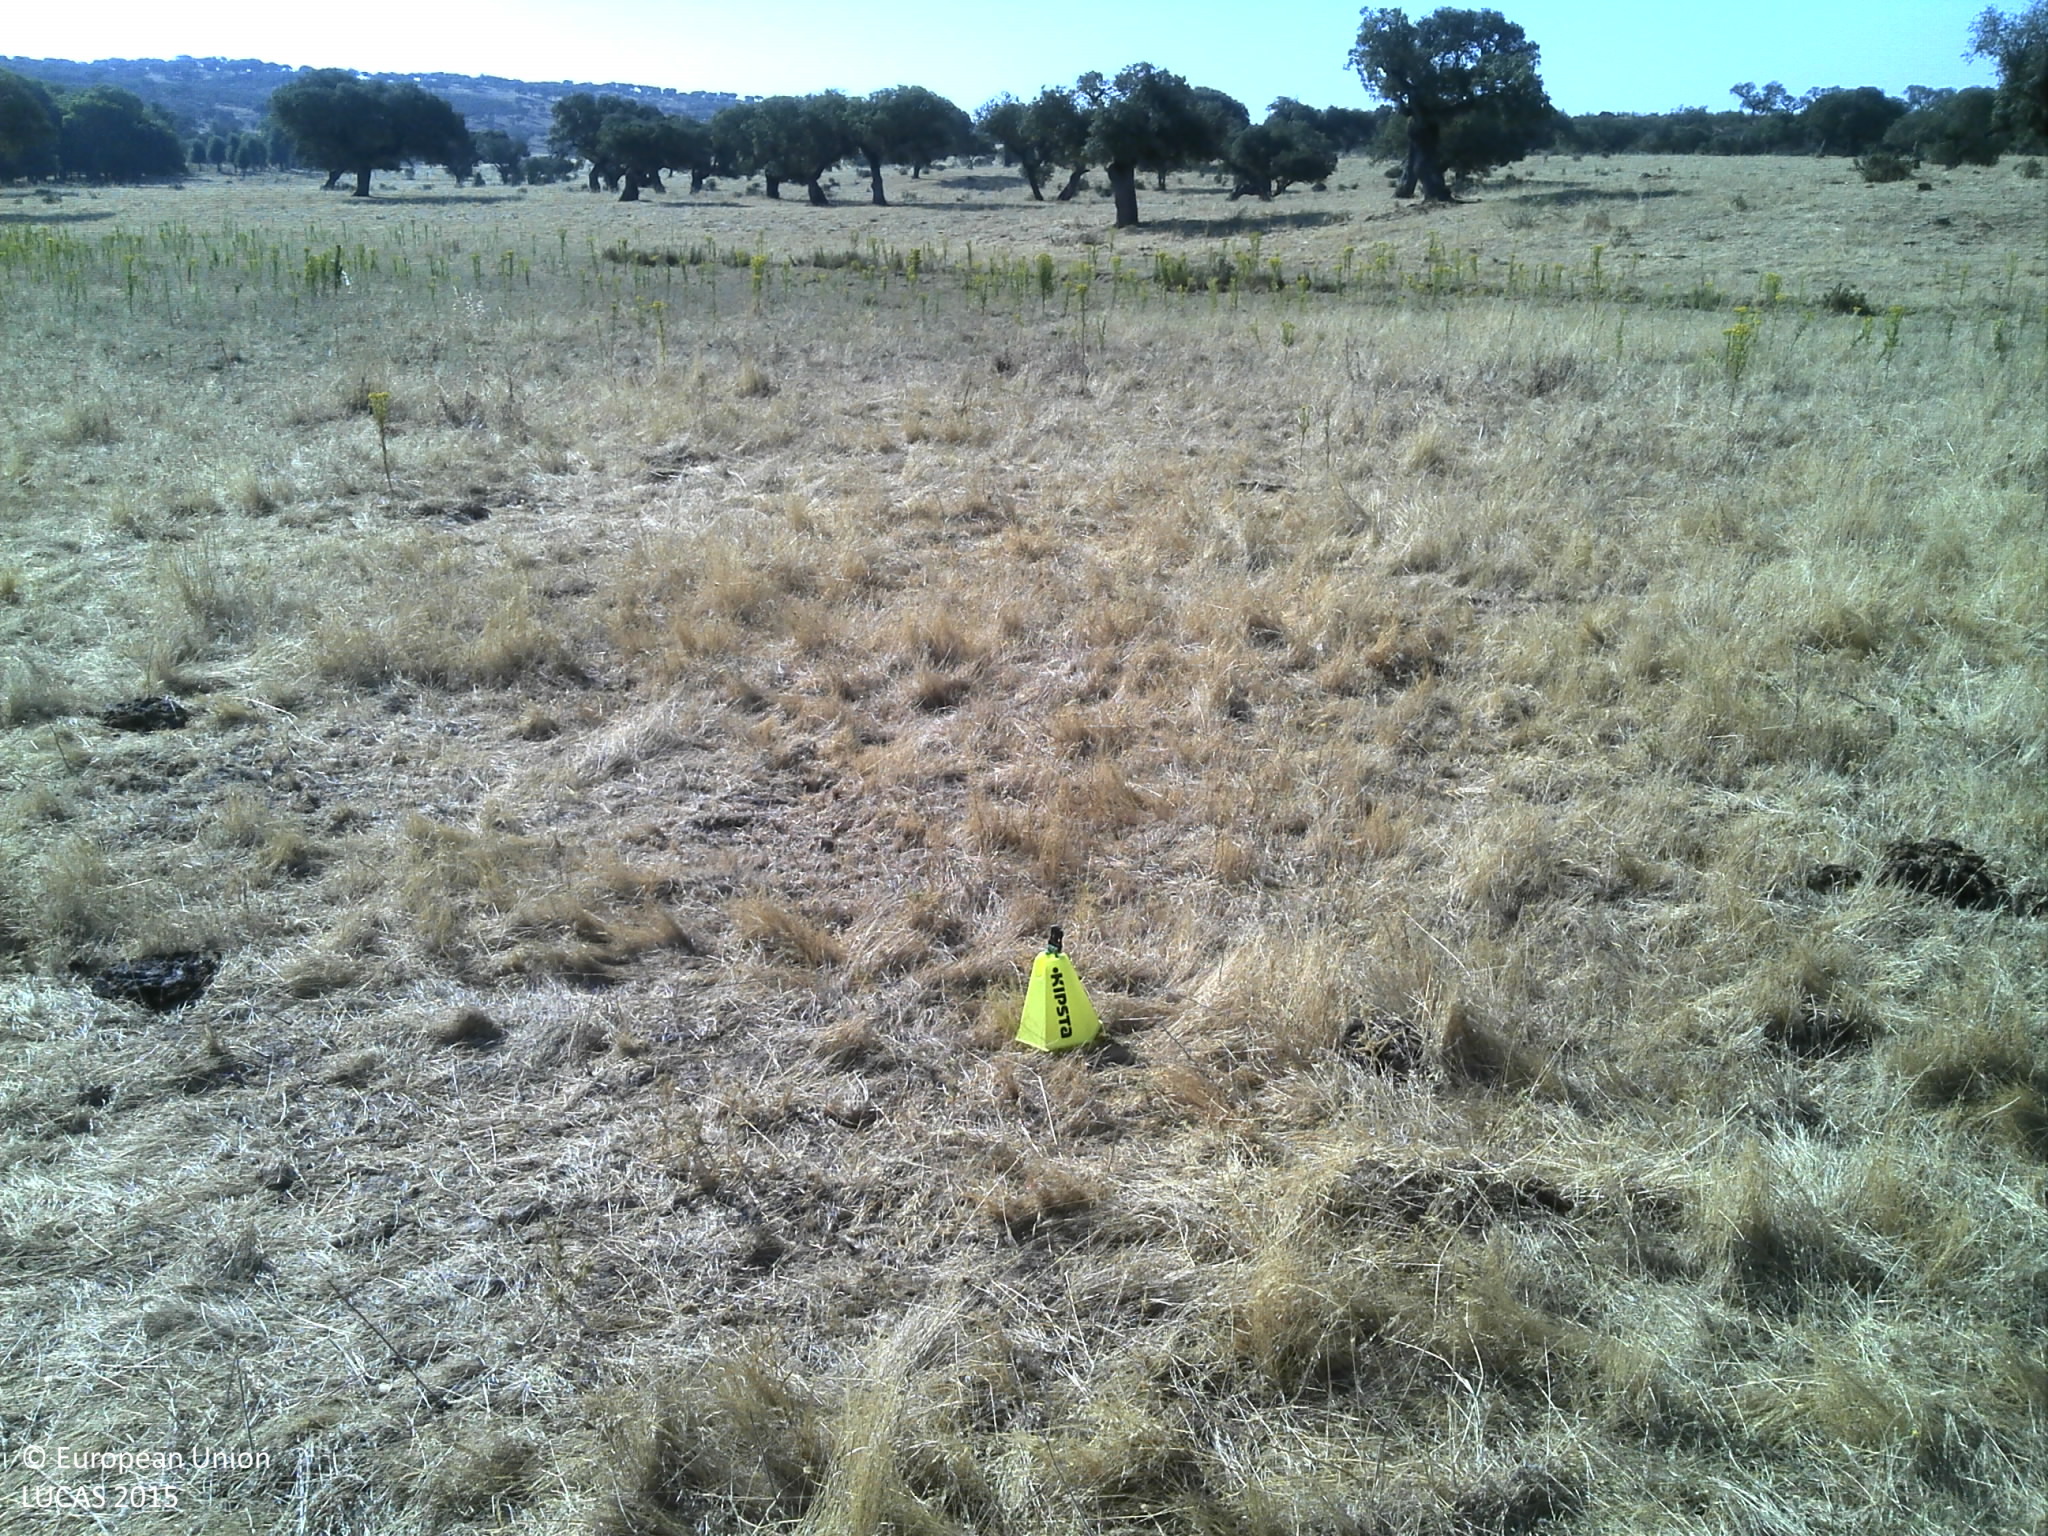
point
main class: Grassland
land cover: Grassland without tree/shrub cover
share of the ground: 50 - 75 %
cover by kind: herbaceous plants 60 %, unconsolidated bare surface 40 %
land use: Agriculture (excluding fallow land and kitchen gardens)
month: July
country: PT
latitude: 38.6619
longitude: -7.2998
